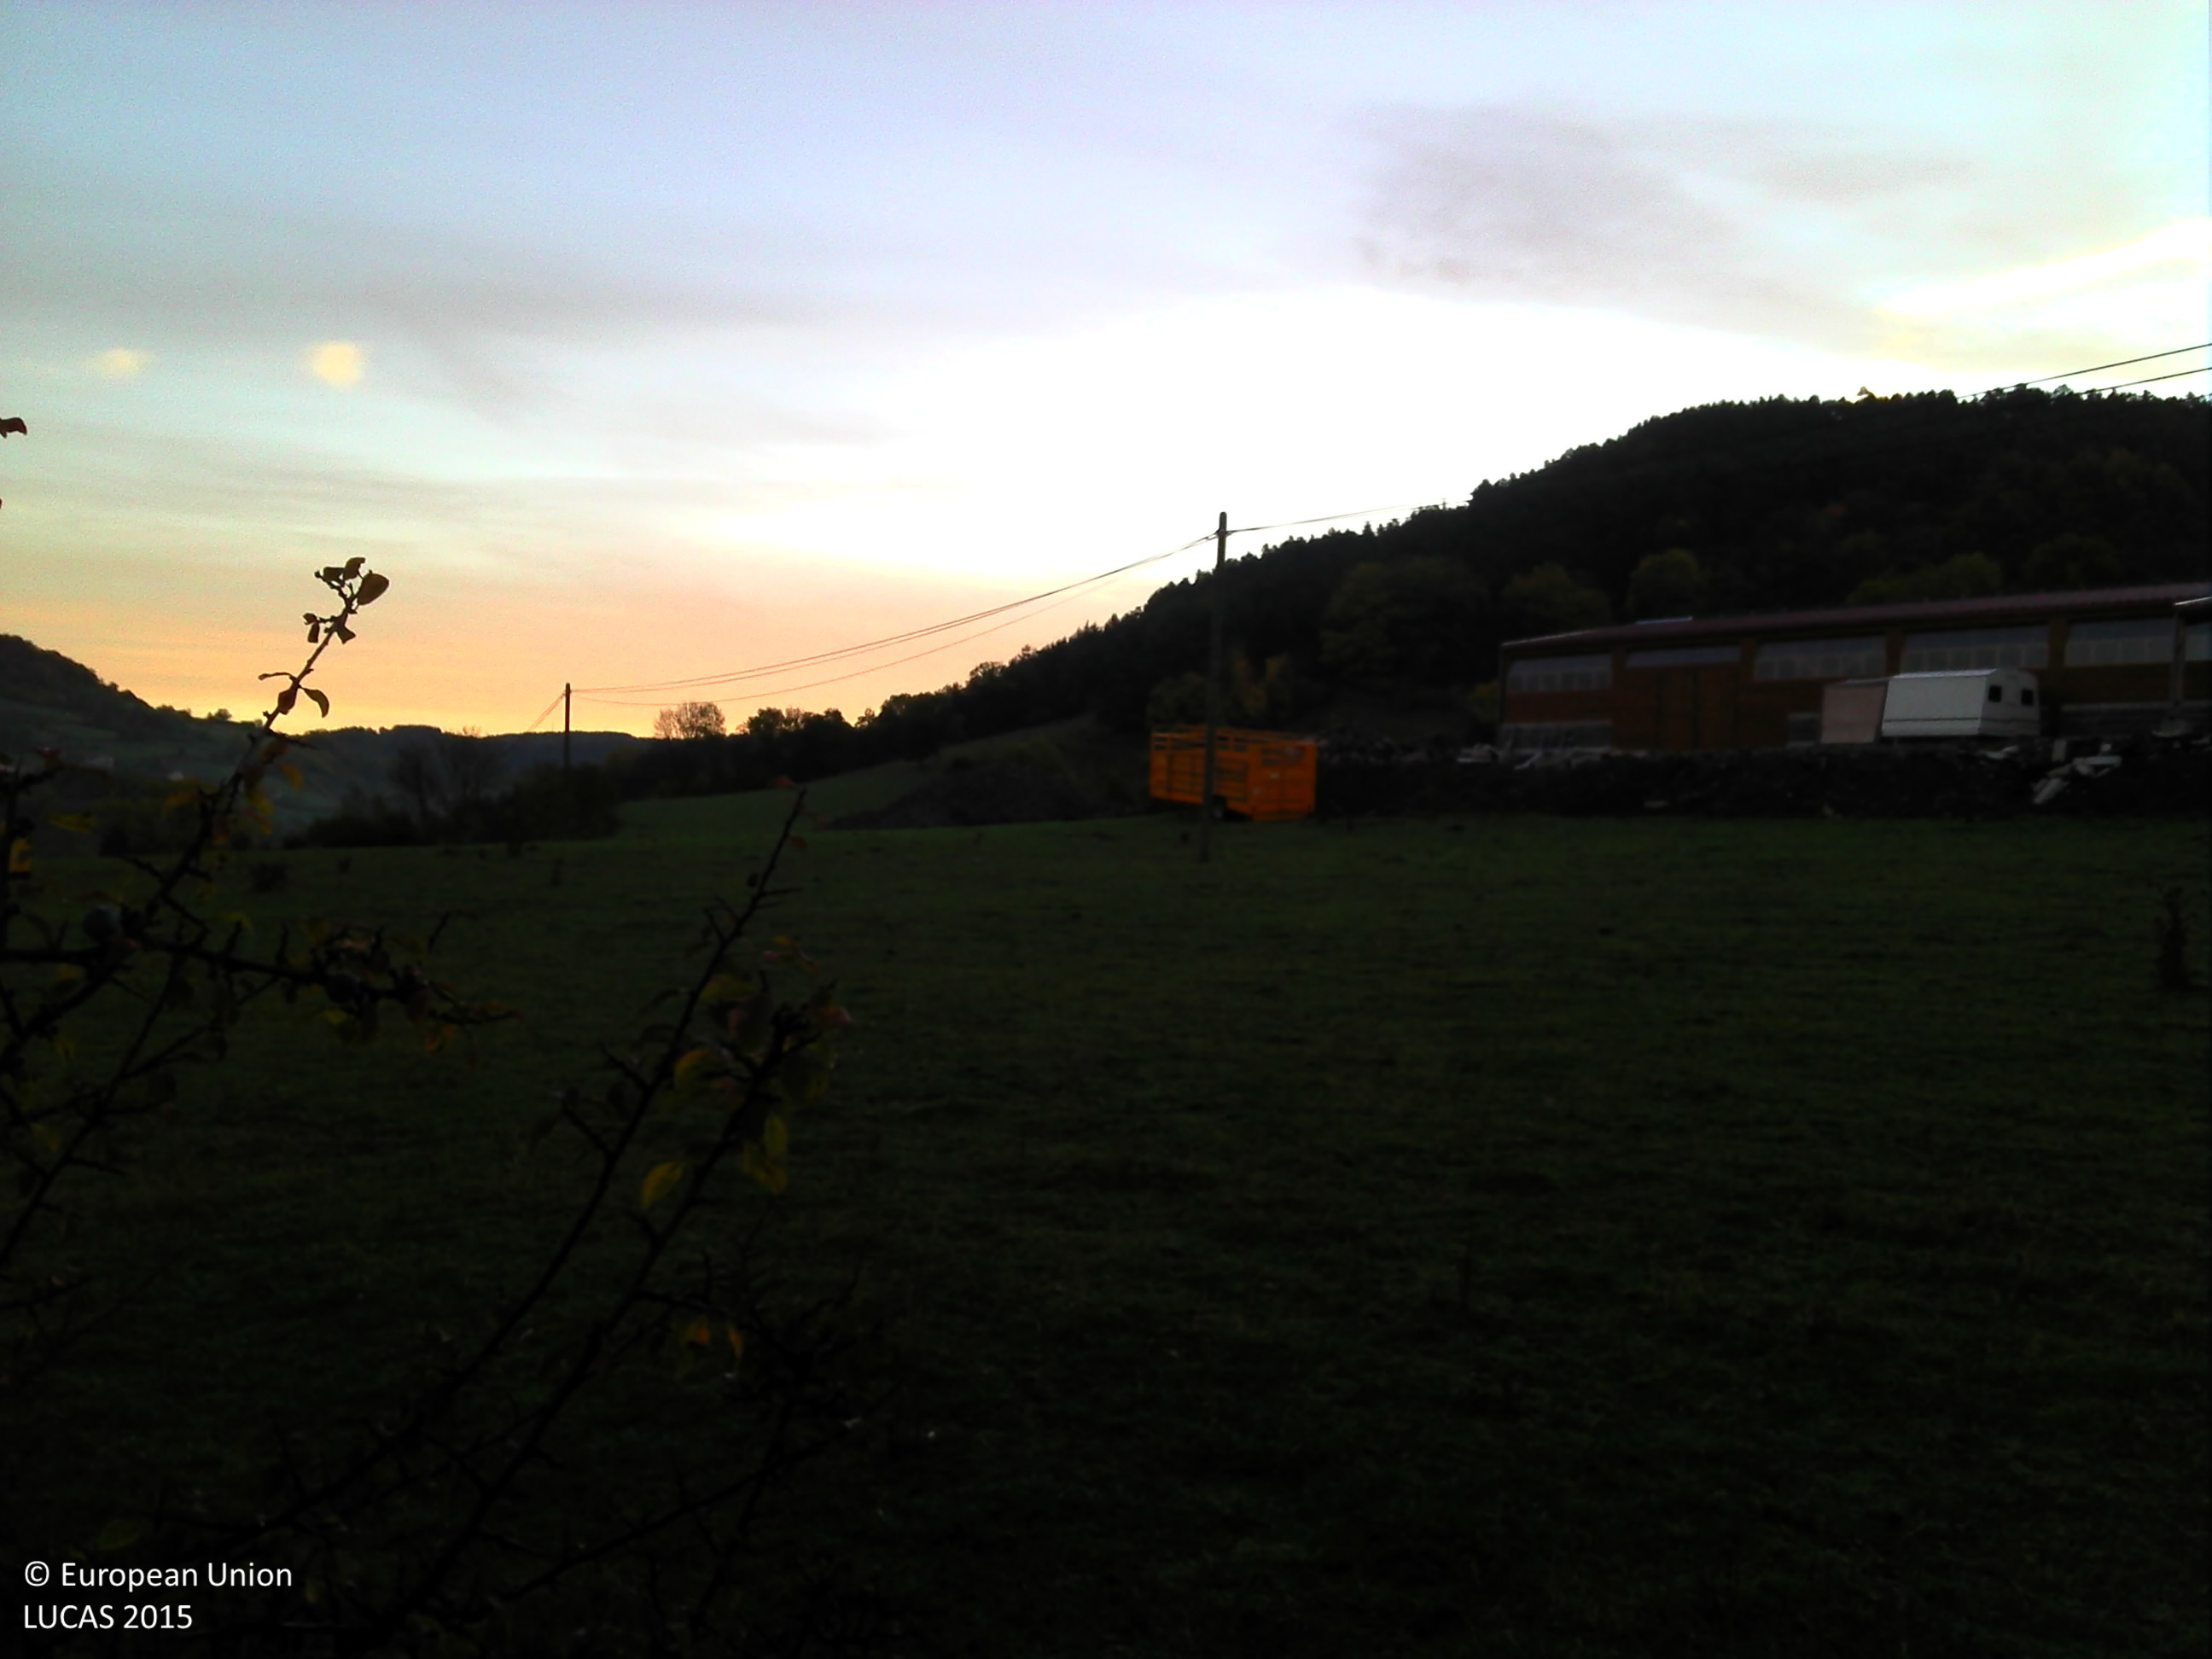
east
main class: Cropland
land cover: Common wheat
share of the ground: 25 - 50 %
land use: Agriculture (excluding fallow land and kitchen gardens)
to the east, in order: Abandoned hedges; Fences; Grassland without tree/shrub cover; Electric lines; Grassland without tree/shrub cover; Artificial constructions in urban areas; Other bare soil; Grassland without tree/shrub cover; Fences; Broadleaved woodland; Rivers and streams; Broadleaved woodland; Grassland without tree/shrub cover
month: October
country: FR
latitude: 45.0911
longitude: 3.8669
